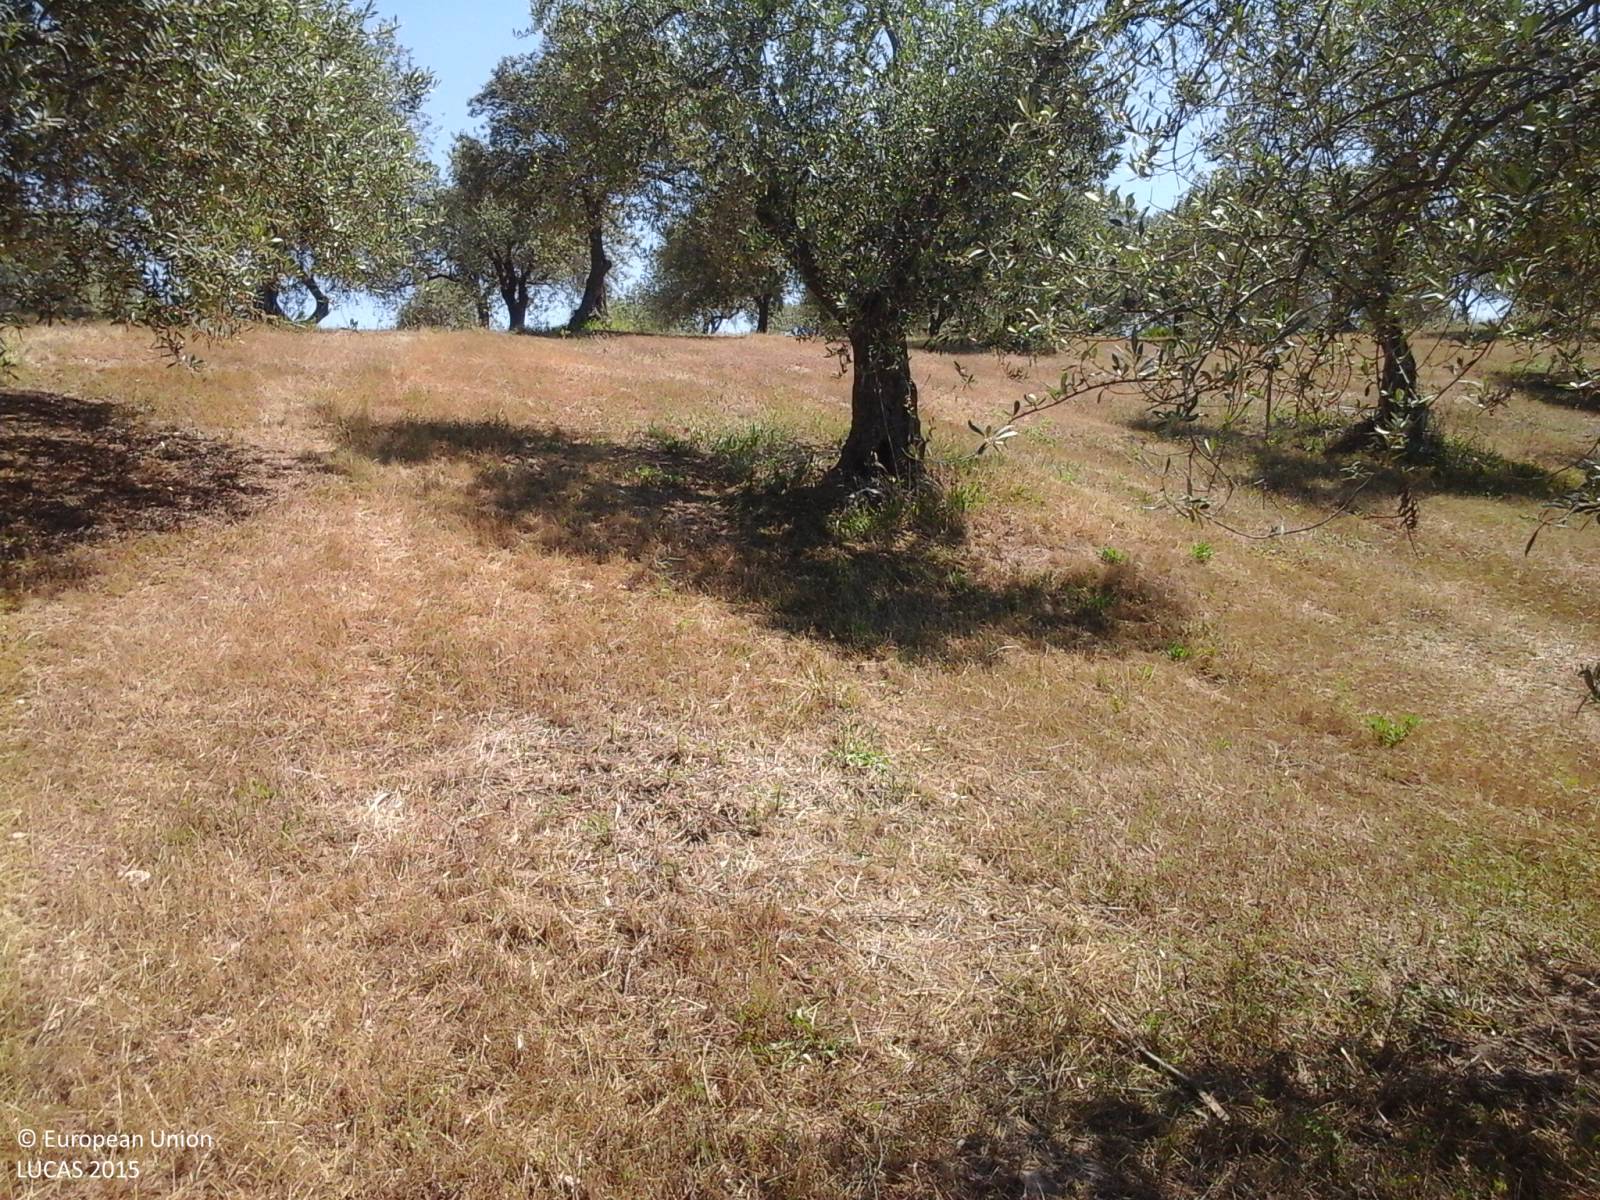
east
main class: Cropland
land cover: Olive groves
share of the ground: 25 - 50 %
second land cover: Spontaneously vegetated surfaces
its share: 50 - 75 %
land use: Agriculture (excluding fallow land and kitchen gardens)
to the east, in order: Olive groves; Spontaneously vegetated surfaces; Dry stone walls; Grass margins; Paved roads, cycling and walking lanes; Grass margins; Fences; Olive groves; Dry stone walls; Olive groves; Tracks; Olive groves
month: May
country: IT
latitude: 40.6538
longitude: 8.4817
